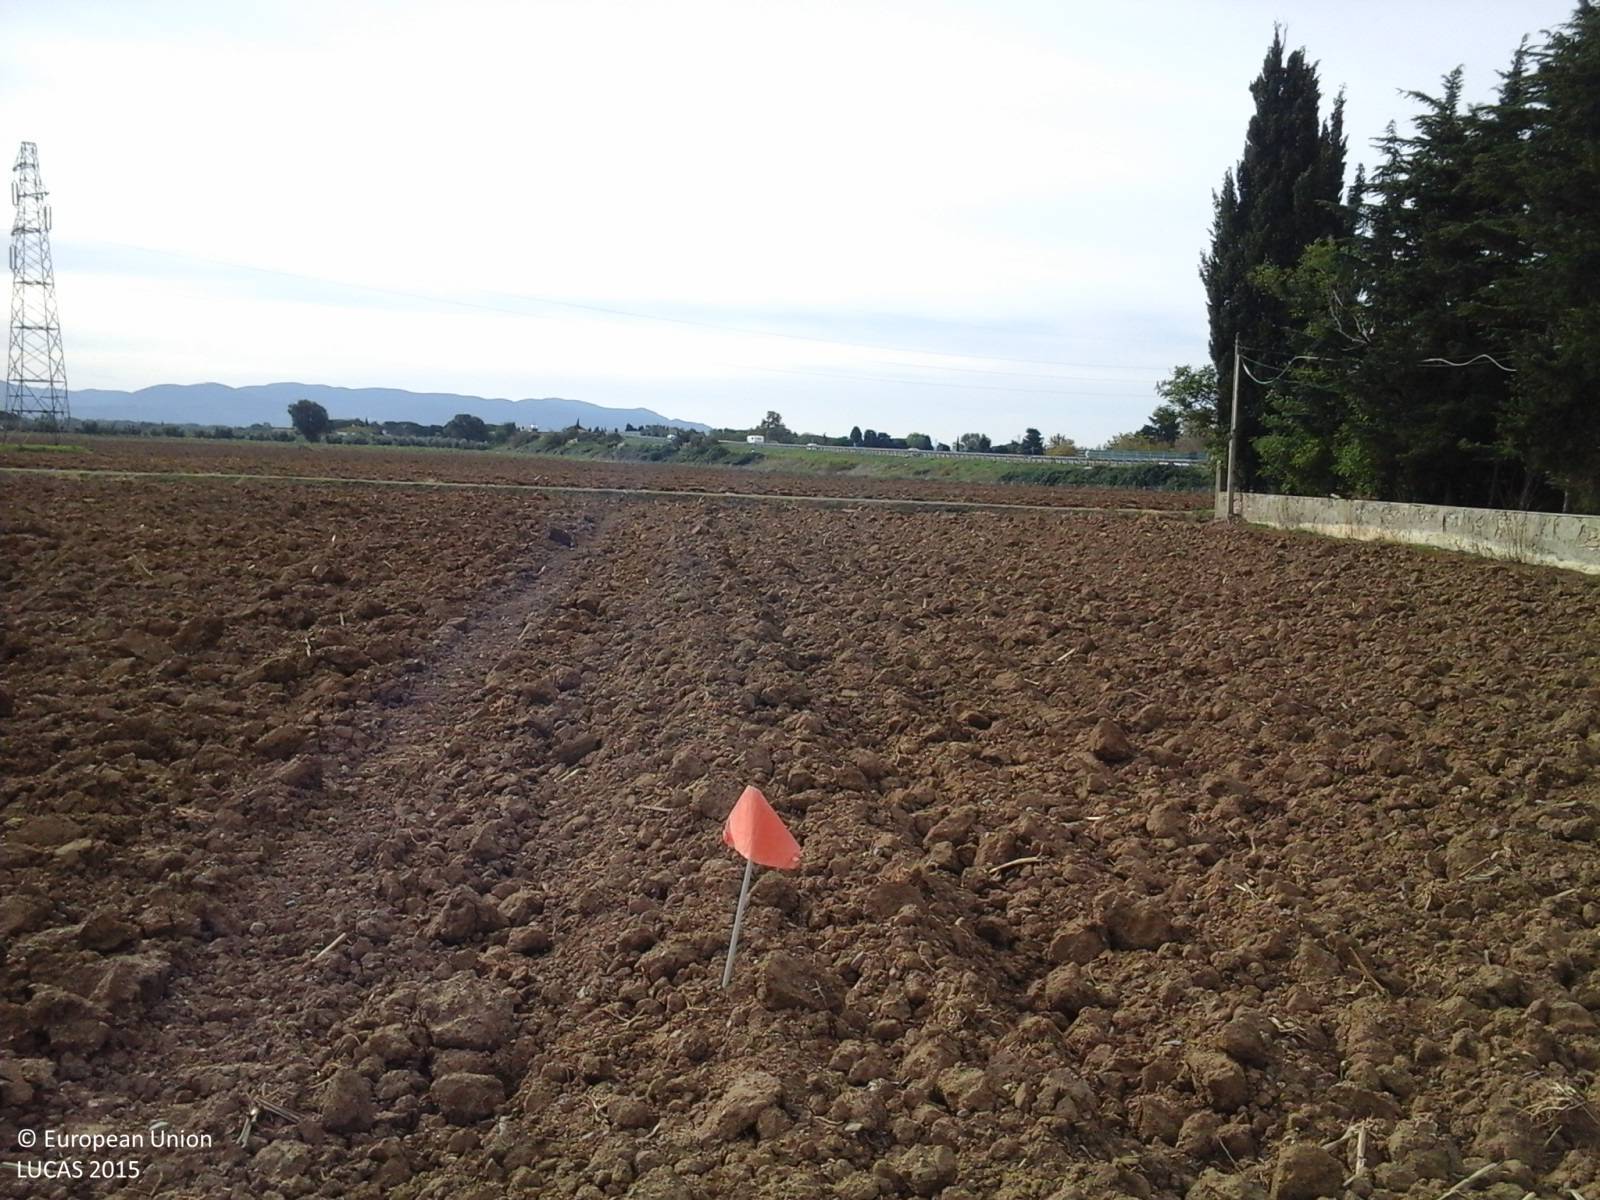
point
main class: Cropland
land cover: Maize
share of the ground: < 10 %
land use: Agriculture (excluding fallow land and kitchen gardens)
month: October
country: IT
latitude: 43.2484
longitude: 10.5526
